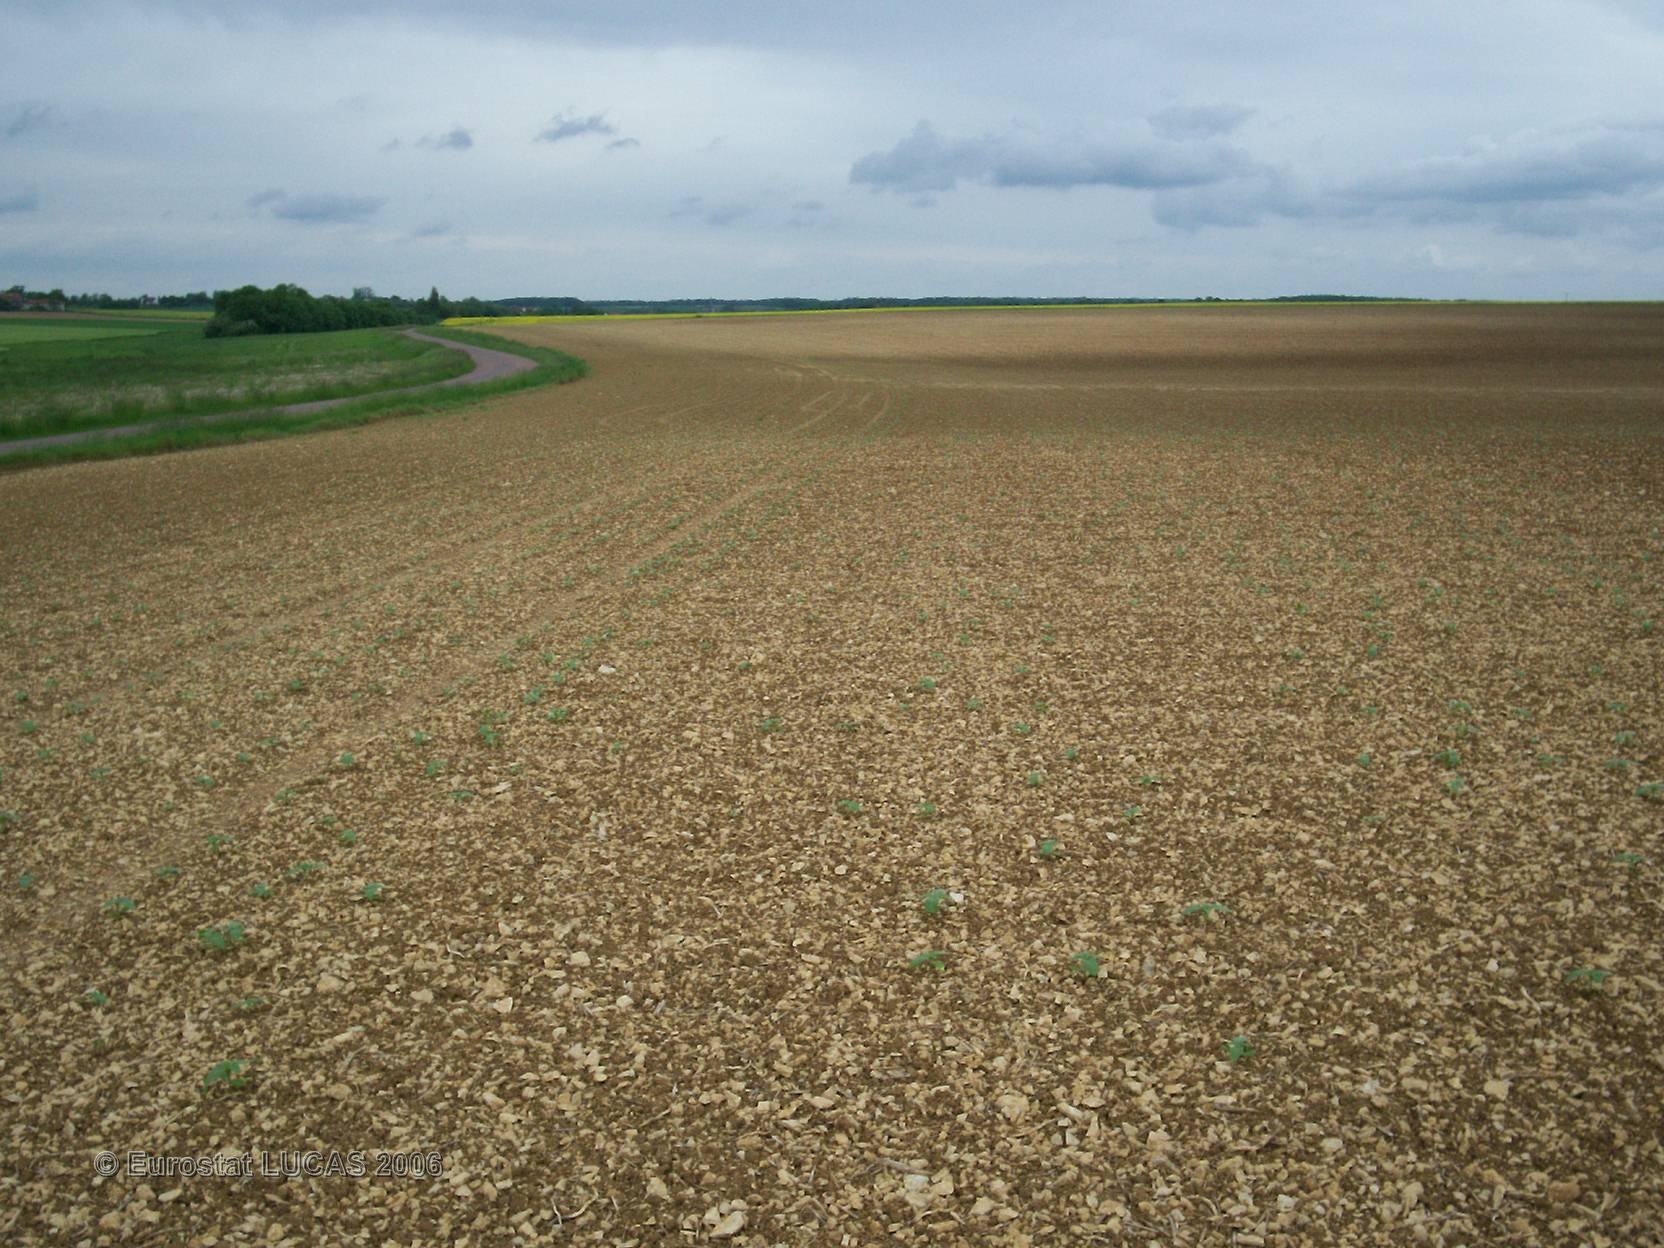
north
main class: Cropland
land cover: Sunflower
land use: Agriculture (excluding fallow land and kitchen gardens)
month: May
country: FR
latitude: 48.2109
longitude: 4.4666
